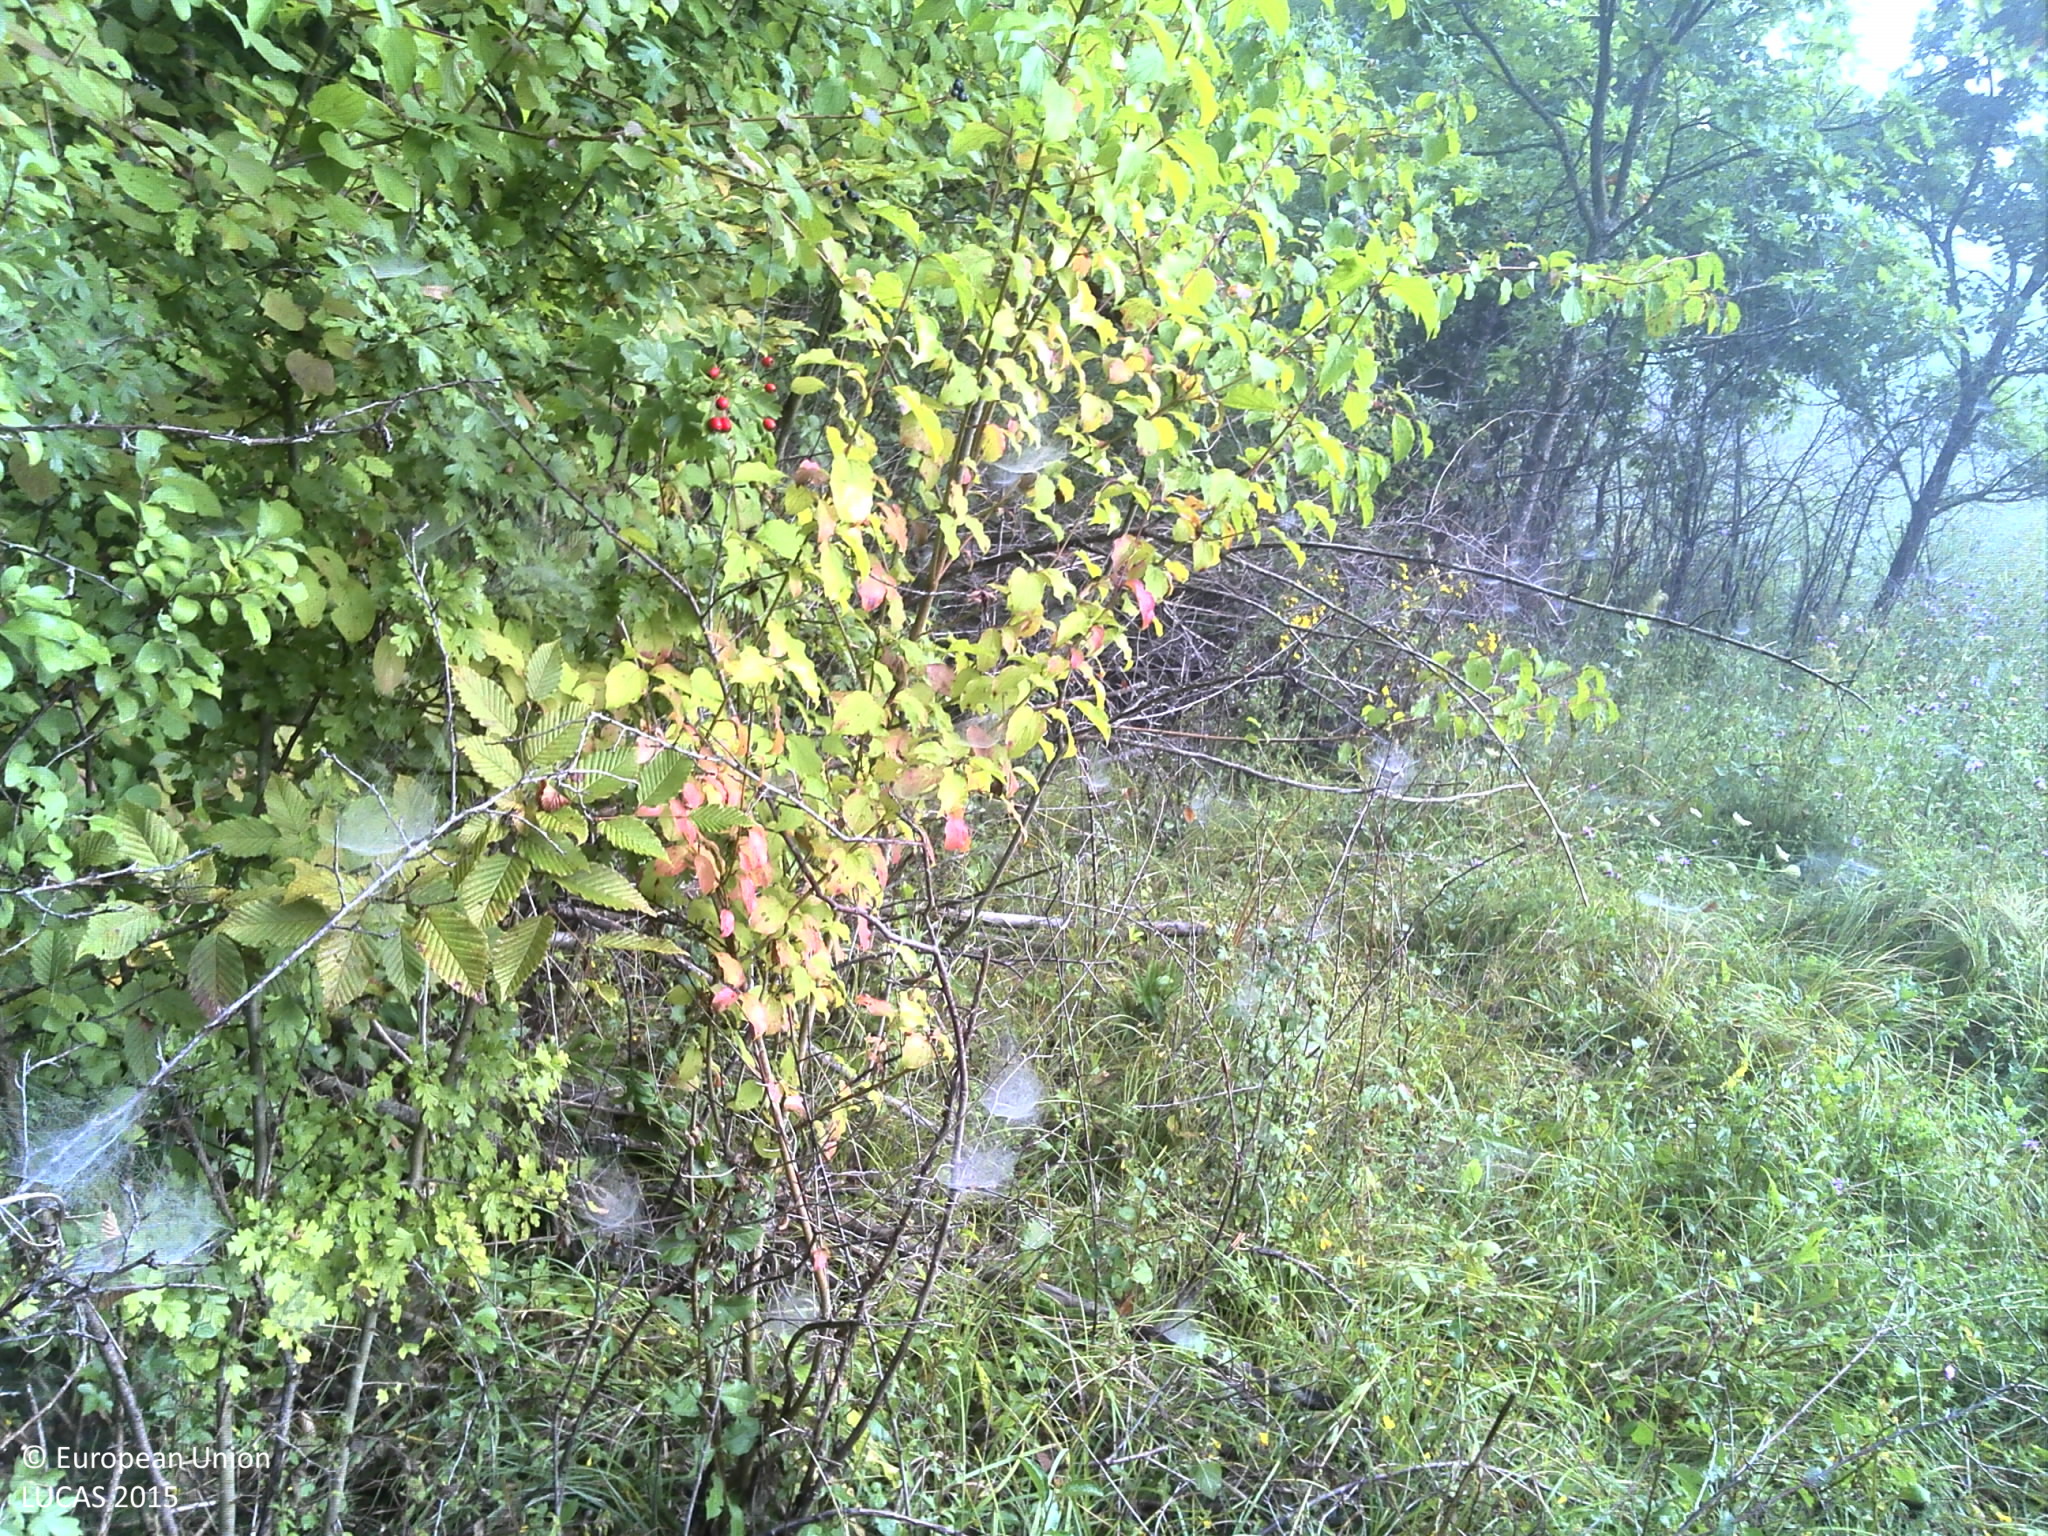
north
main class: Grassland
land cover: Spontaneously vegetated surfaces
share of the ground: > 75 %
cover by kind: herbaceous plants 95 %, shrubs 5 %
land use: Semi-natural and natural areas not in use
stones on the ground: < 10 %
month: August
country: HR
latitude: 45.1689
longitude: 16.3457
